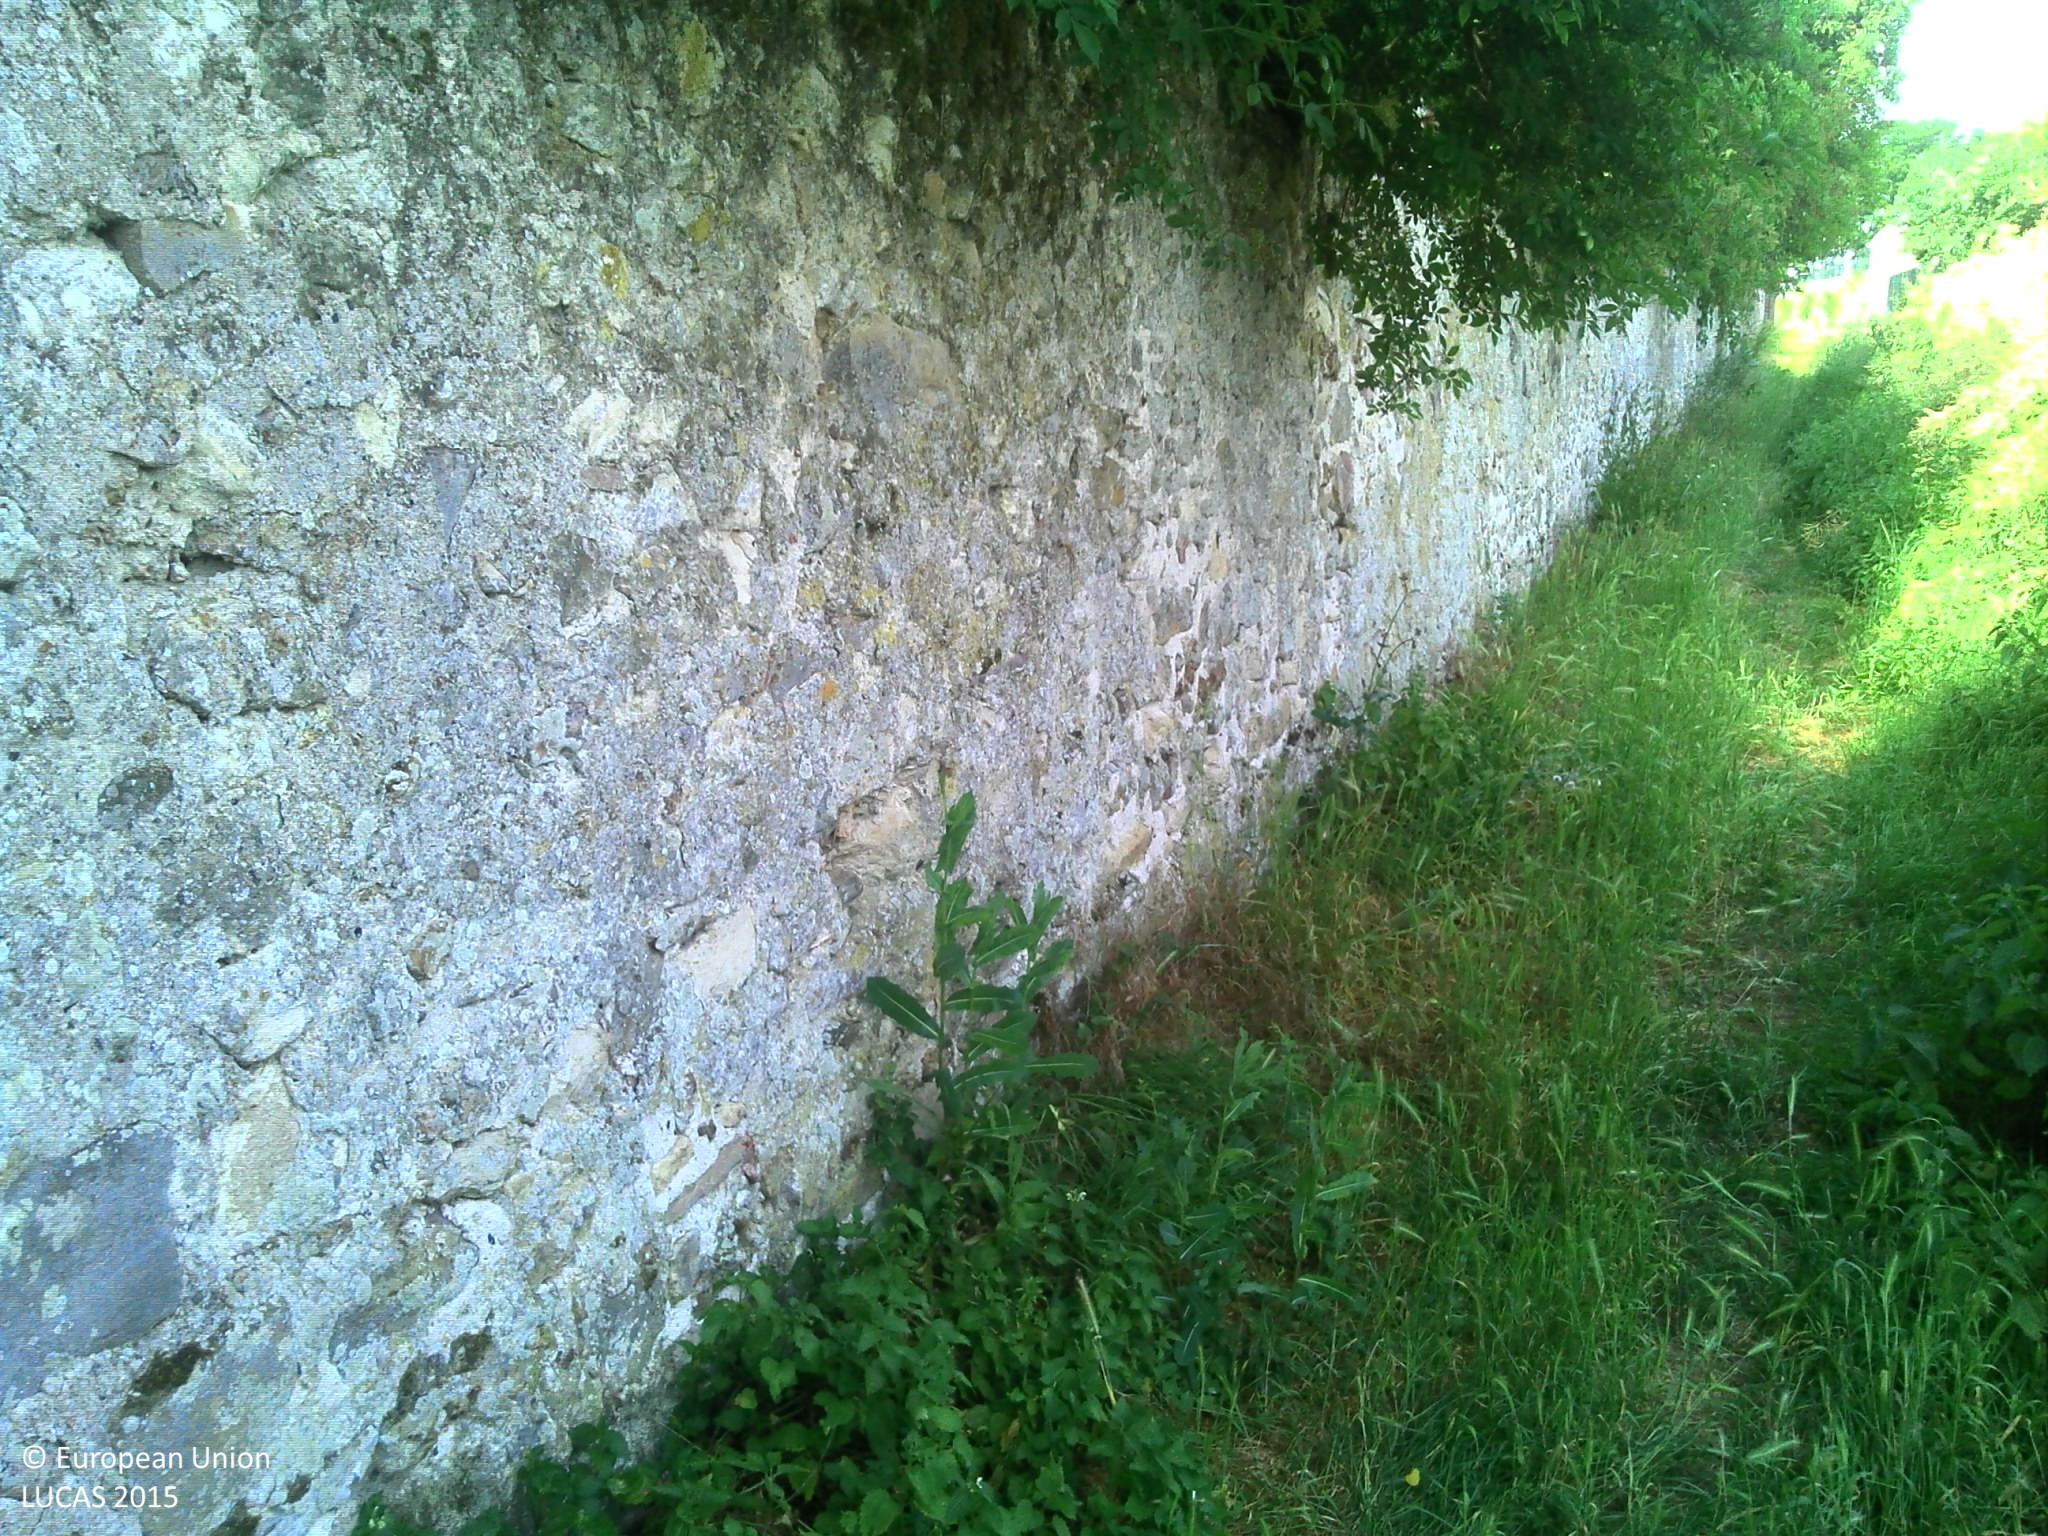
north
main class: Cropland
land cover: Rape and turnip rape
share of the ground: > 75 %
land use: Agriculture (excluding fallow land and kitchen gardens)
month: July
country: FR
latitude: 49.1220
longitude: 3.3193
